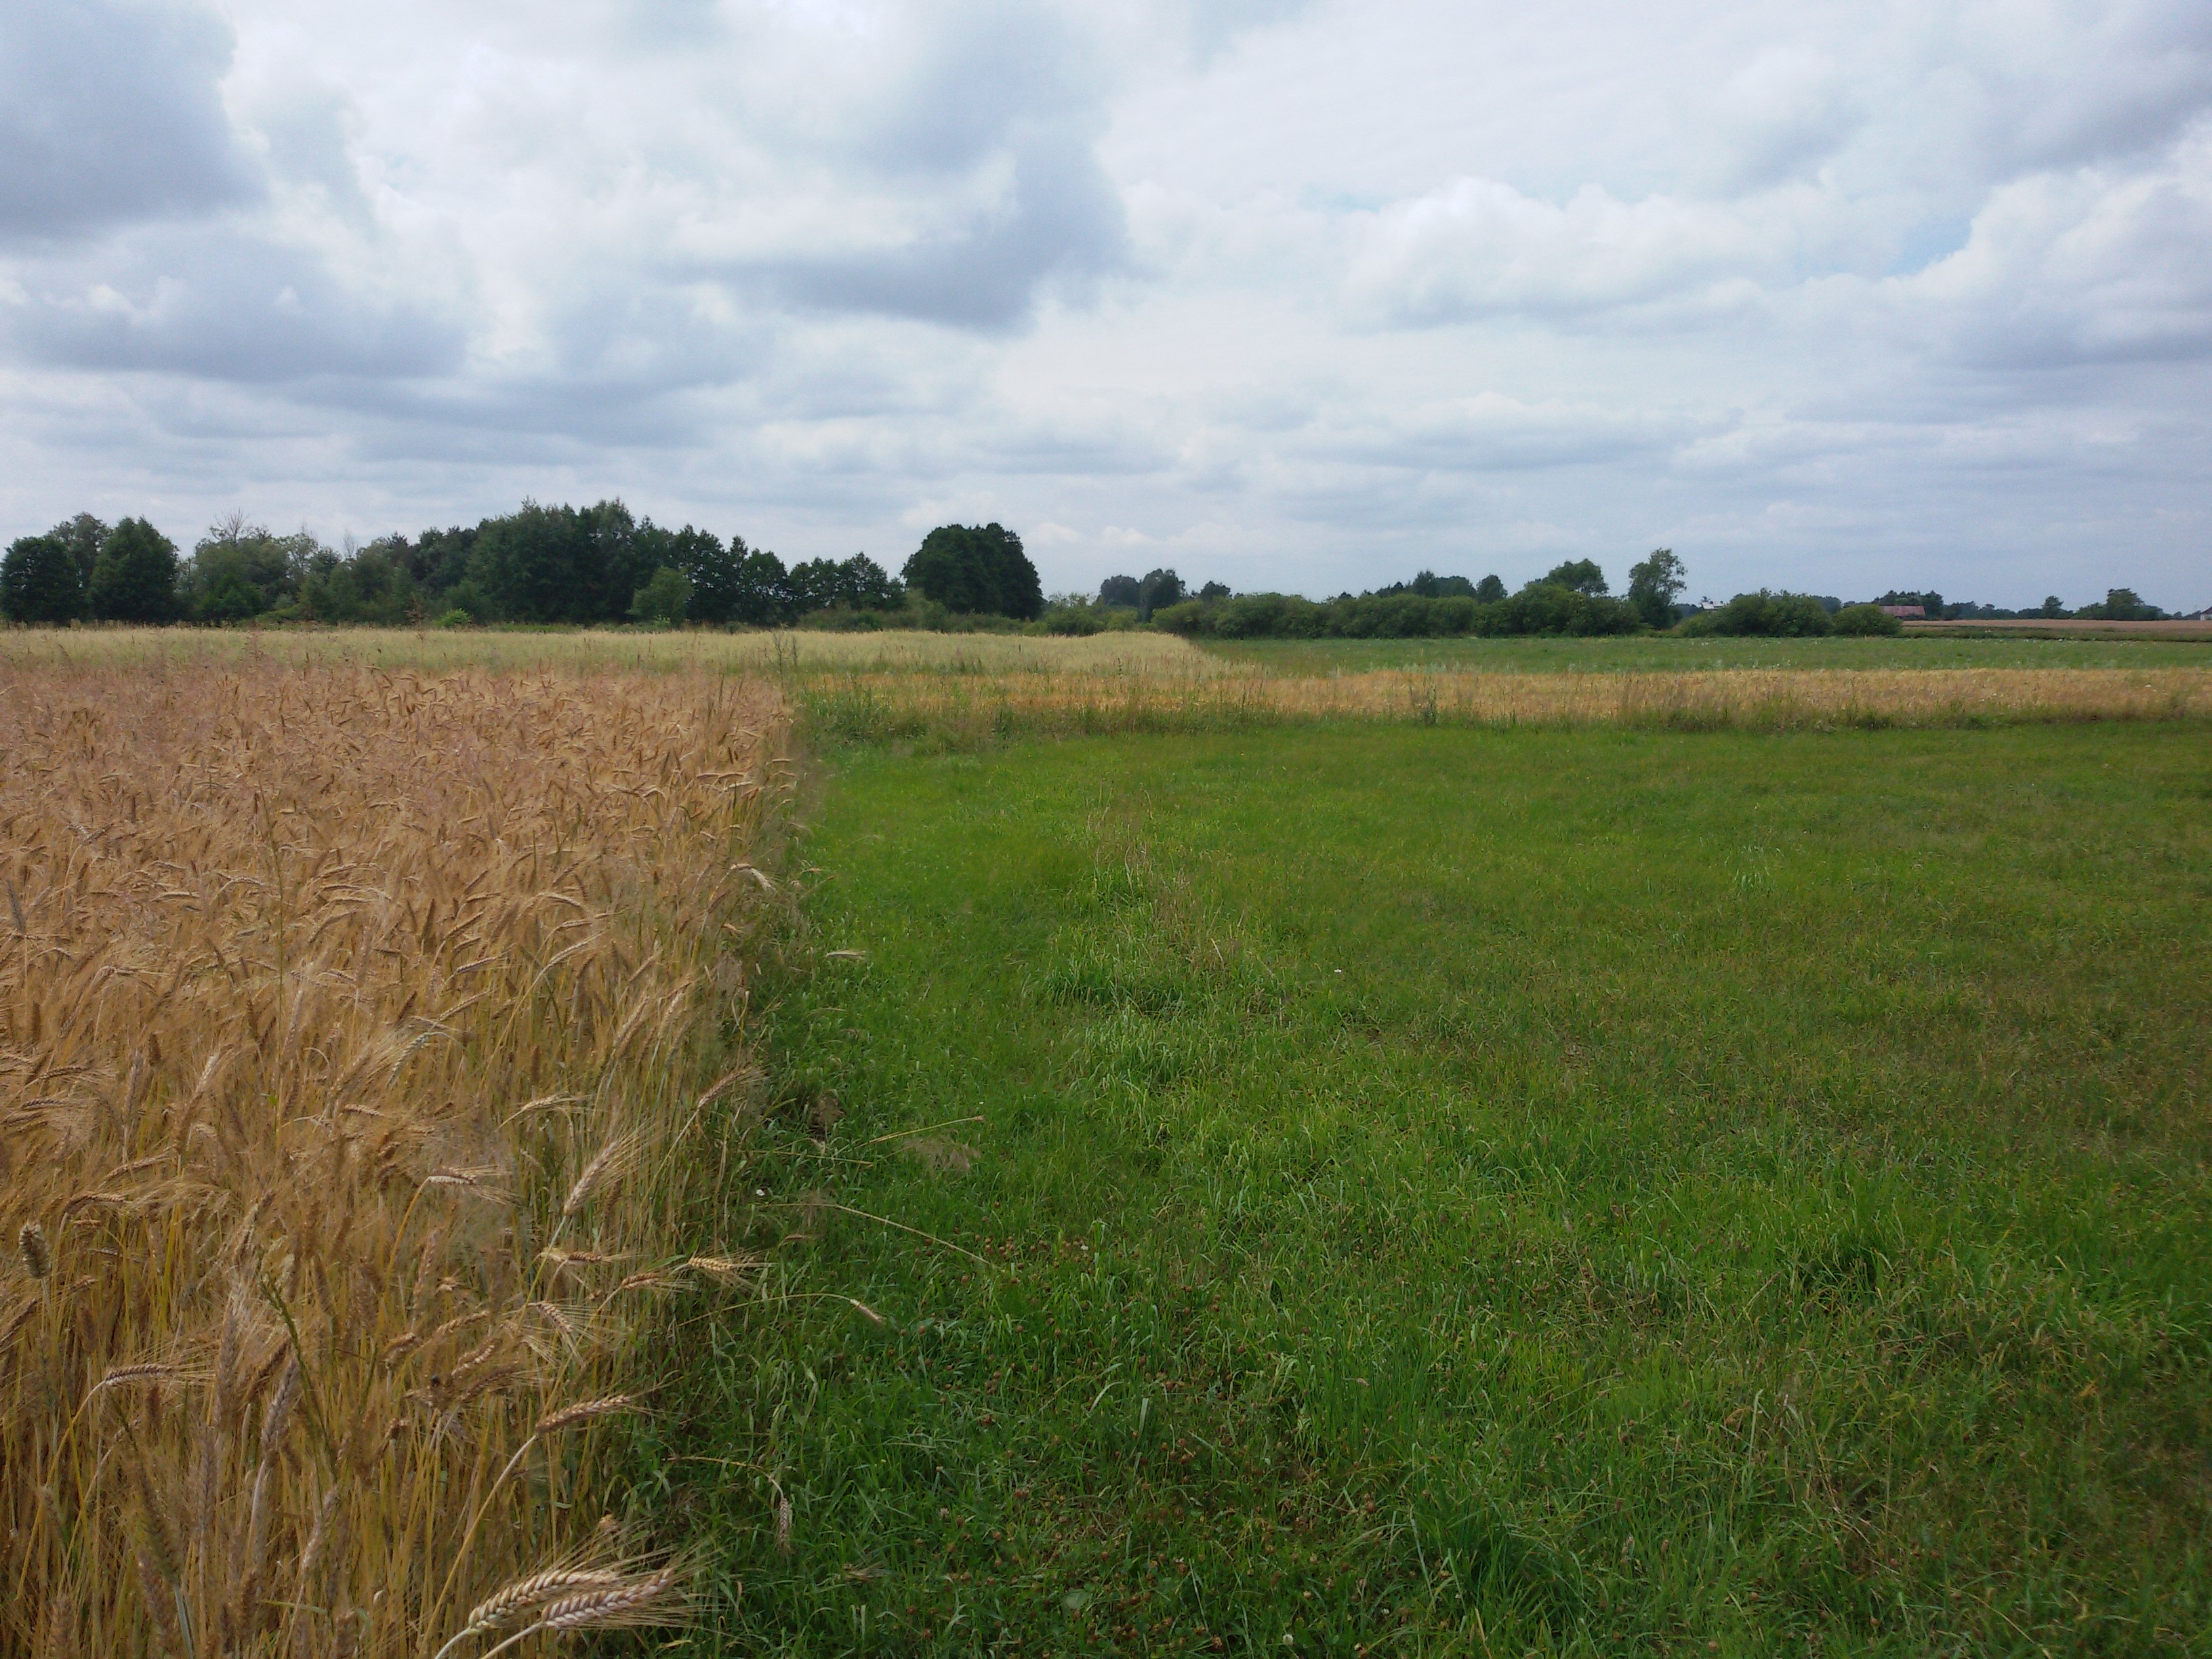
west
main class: Cropland
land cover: Triticale
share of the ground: > 75 %
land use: Agriculture (excluding fallow land and kitchen gardens)
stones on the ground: < 10 %
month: July
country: PL
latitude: 51.8881
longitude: 22.9030
